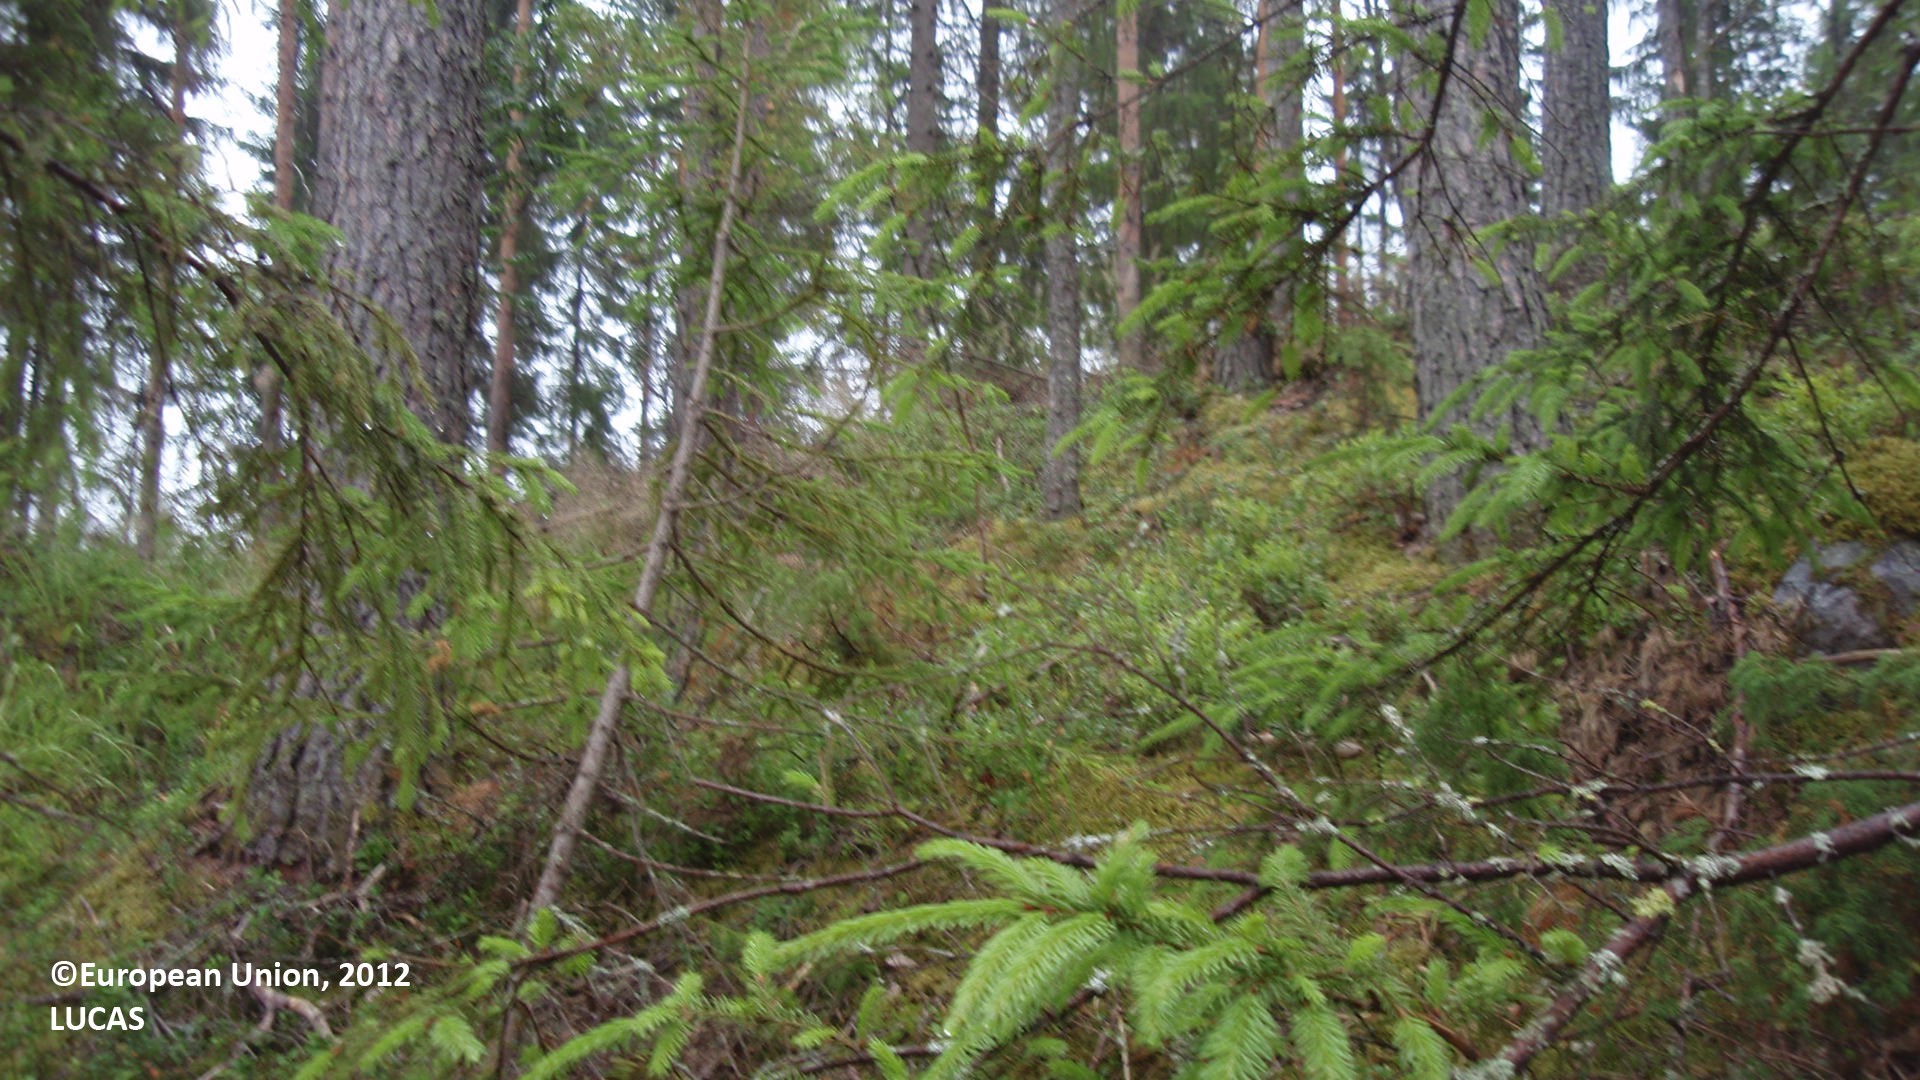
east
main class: Woodland
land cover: Pine dominated mixed woodland
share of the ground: 25 - 50 %
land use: Forestry
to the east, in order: Pine dominated mixed woodland; Ditches and canals; Grassland without tree/shrub cover; Ditches and canals; Broadleaved woodland; Spruce dominated mixed woodland; Broadleaved woodland; Grassland with sparse tree/shrub cover; Spruce dominated coniferous woodland
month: July
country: FI
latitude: 61.1207
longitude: 28.7297
